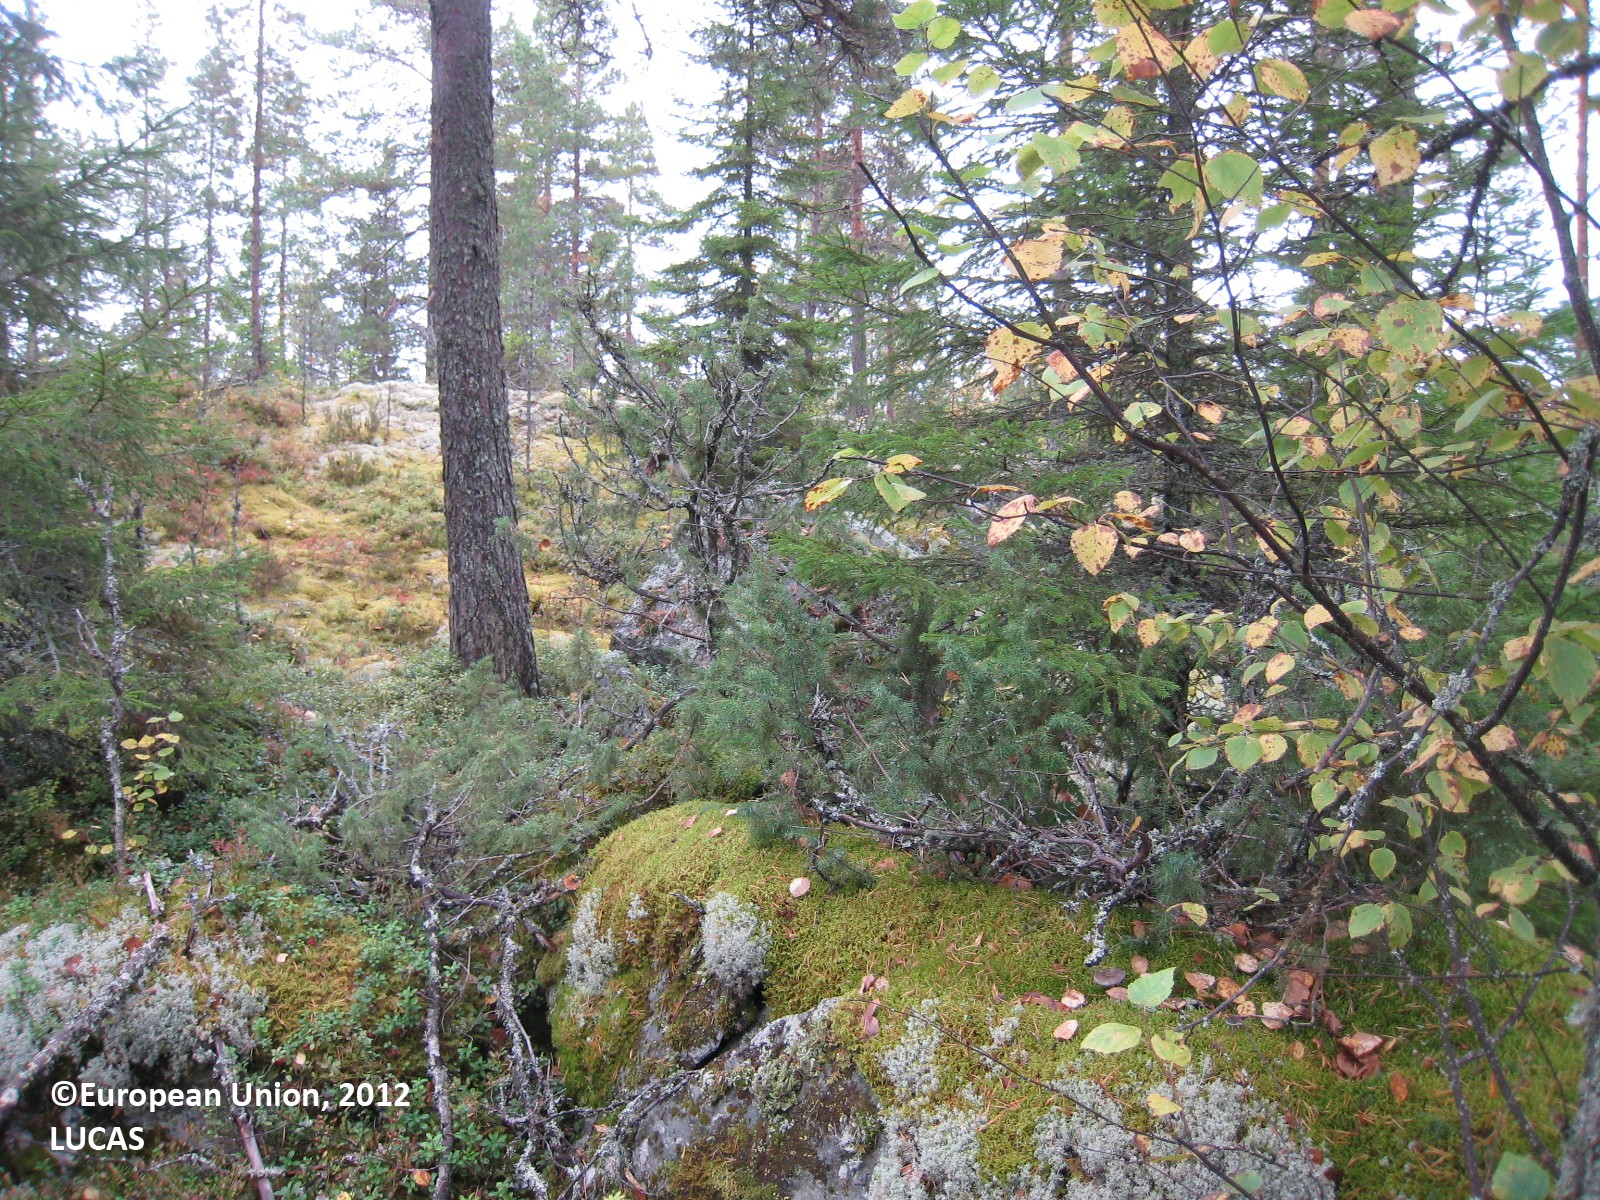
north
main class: Woodland
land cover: Other coniferous woodland
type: boreal forest
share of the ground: 50 - 75 %
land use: Forestry
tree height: > 5 m
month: September
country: FI
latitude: 62.5363
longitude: 26.5625
